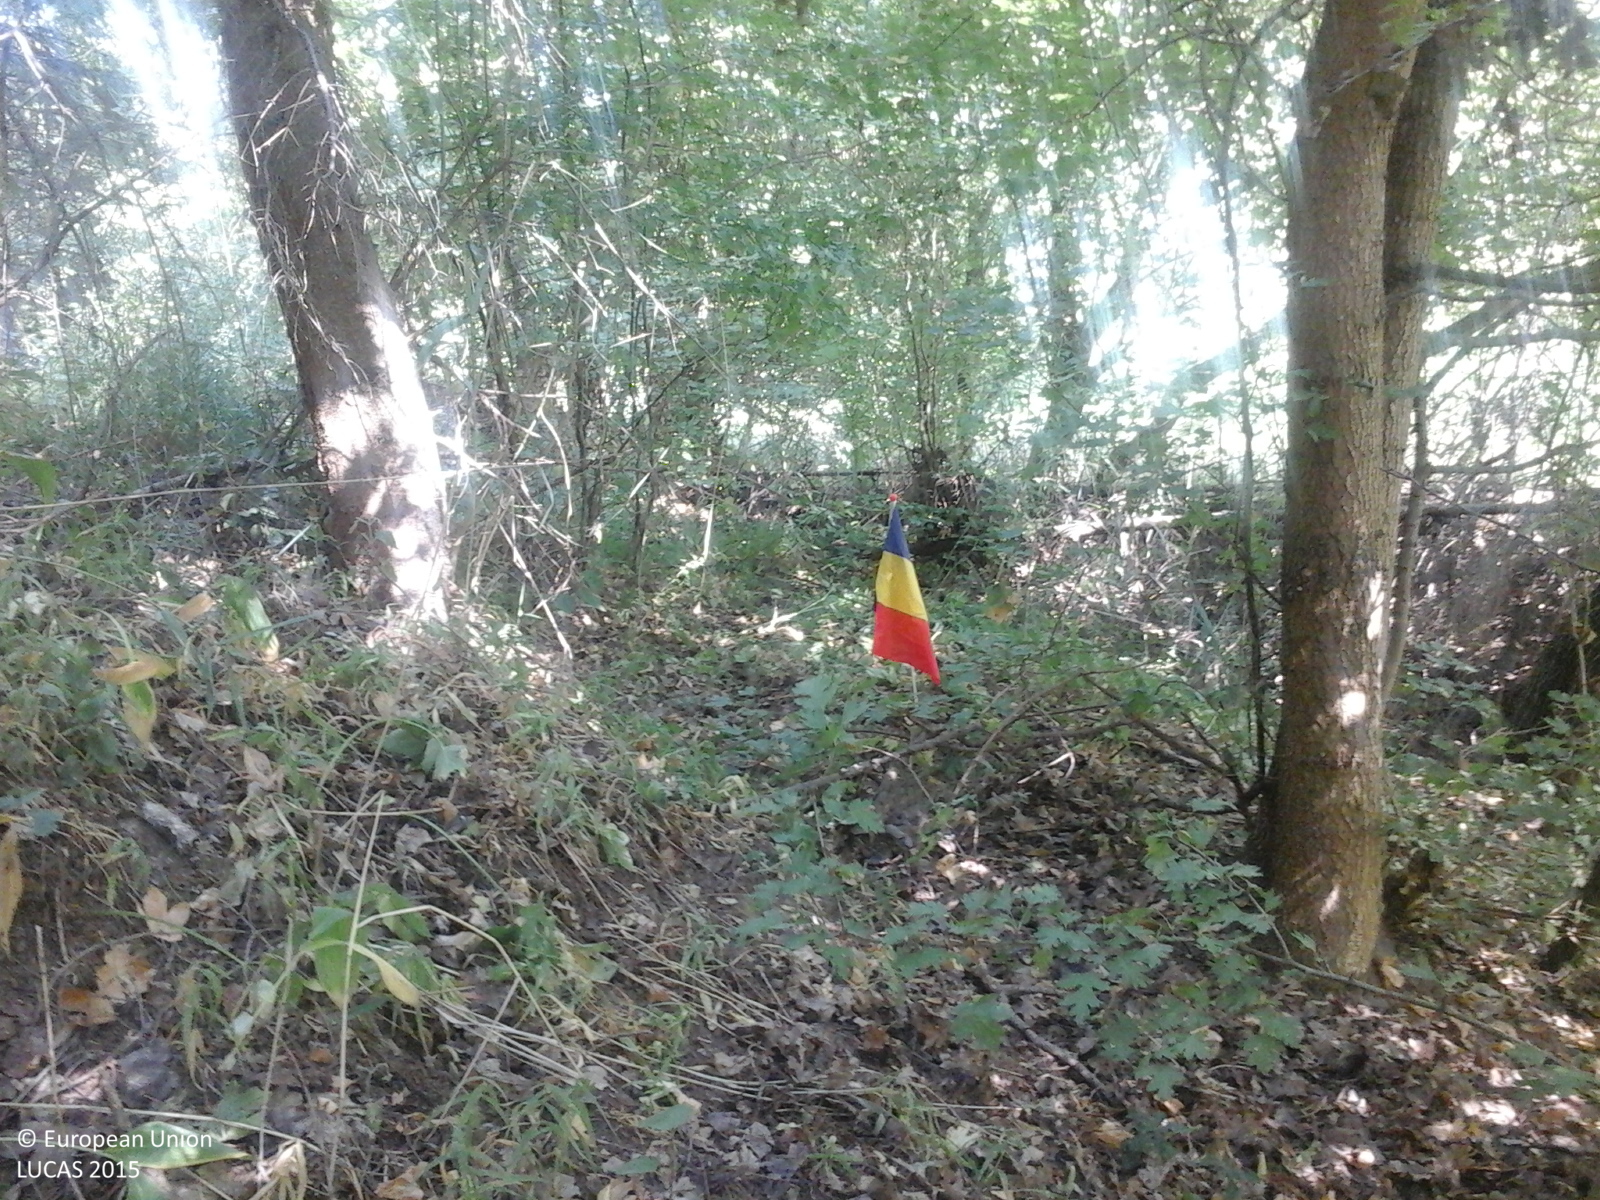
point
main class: Woodland
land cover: Spruce dominated coniferous woodland
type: alpine coniferous forest
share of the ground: > 75 %
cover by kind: coniferous forest trees 75 %, broadleaved forest trees 25 %
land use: Forestry
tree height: > 5 m
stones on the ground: 10 - 25 %
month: July
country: RO
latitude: 46.6110
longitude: 27.2476
